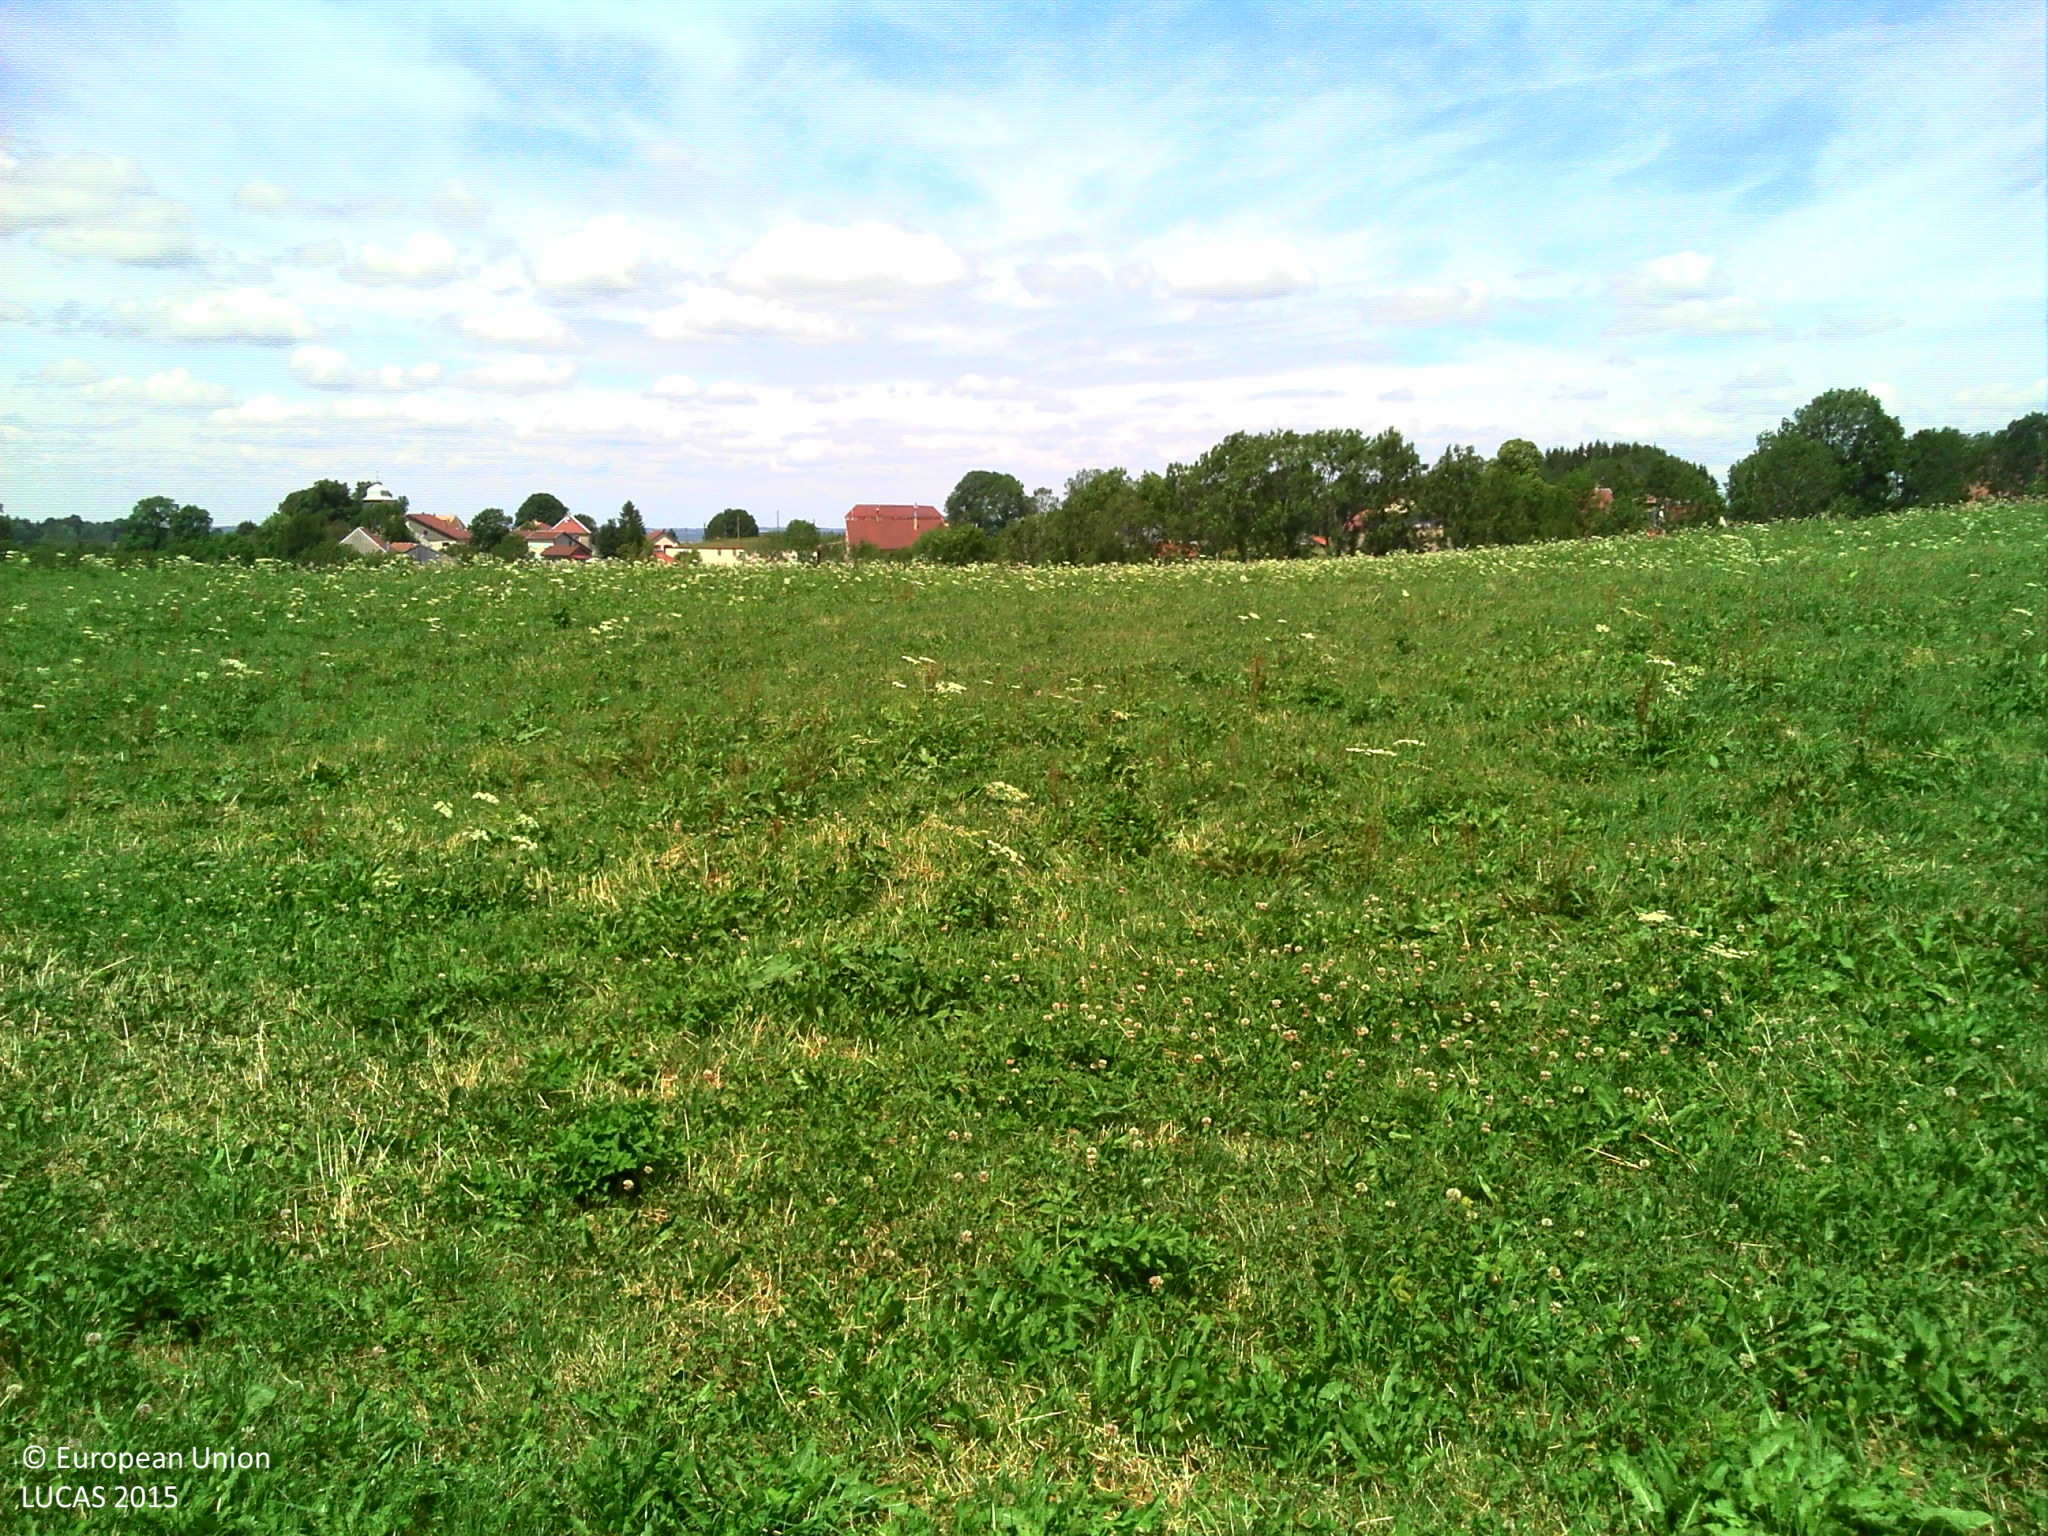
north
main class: Grassland
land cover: Grassland without tree/shrub cover
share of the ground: > 75 %
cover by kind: herbaceous plants 100 %
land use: Agriculture (excluding fallow land and kitchen gardens)
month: July
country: FR
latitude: 46.7305
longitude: 6.0900
